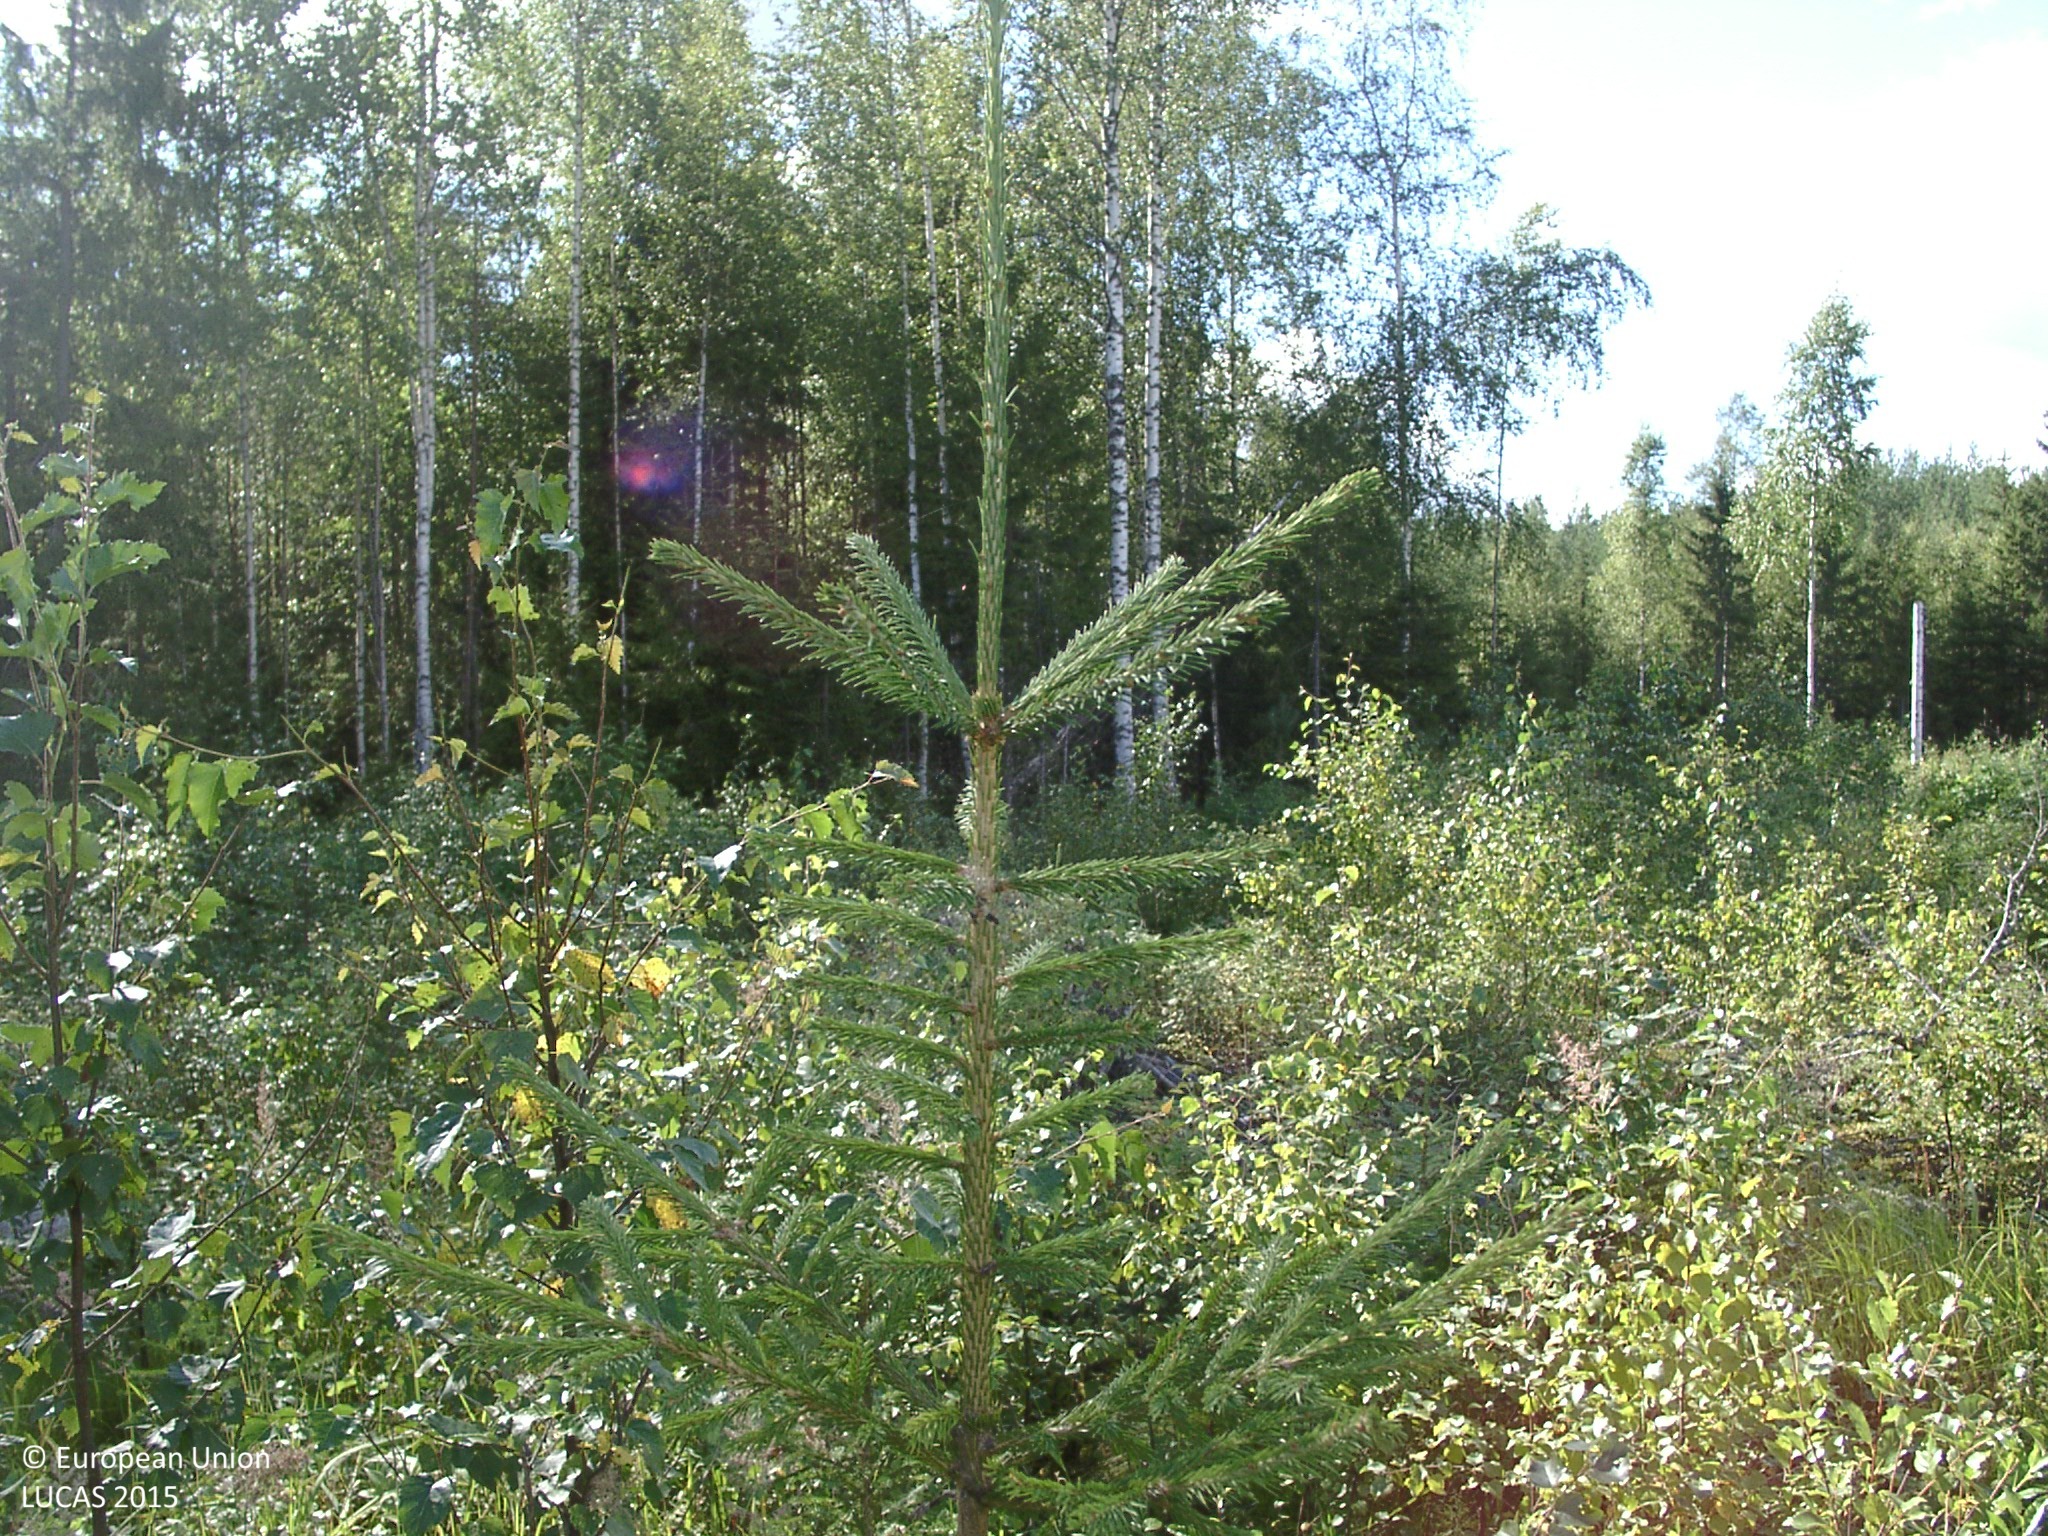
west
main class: Woodland
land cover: Broadleaved woodland
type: boreal forest
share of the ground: 50 - 75 %
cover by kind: broadleaved forest trees 50 %, herbaceous plants 30 %, shrubs 10 %, coniferous forest trees 5 %, lichens and mosses 5 %
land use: Forestry
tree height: < 5 m
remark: Nursery
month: August
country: FI
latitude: 62.4007
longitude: 25.7722
